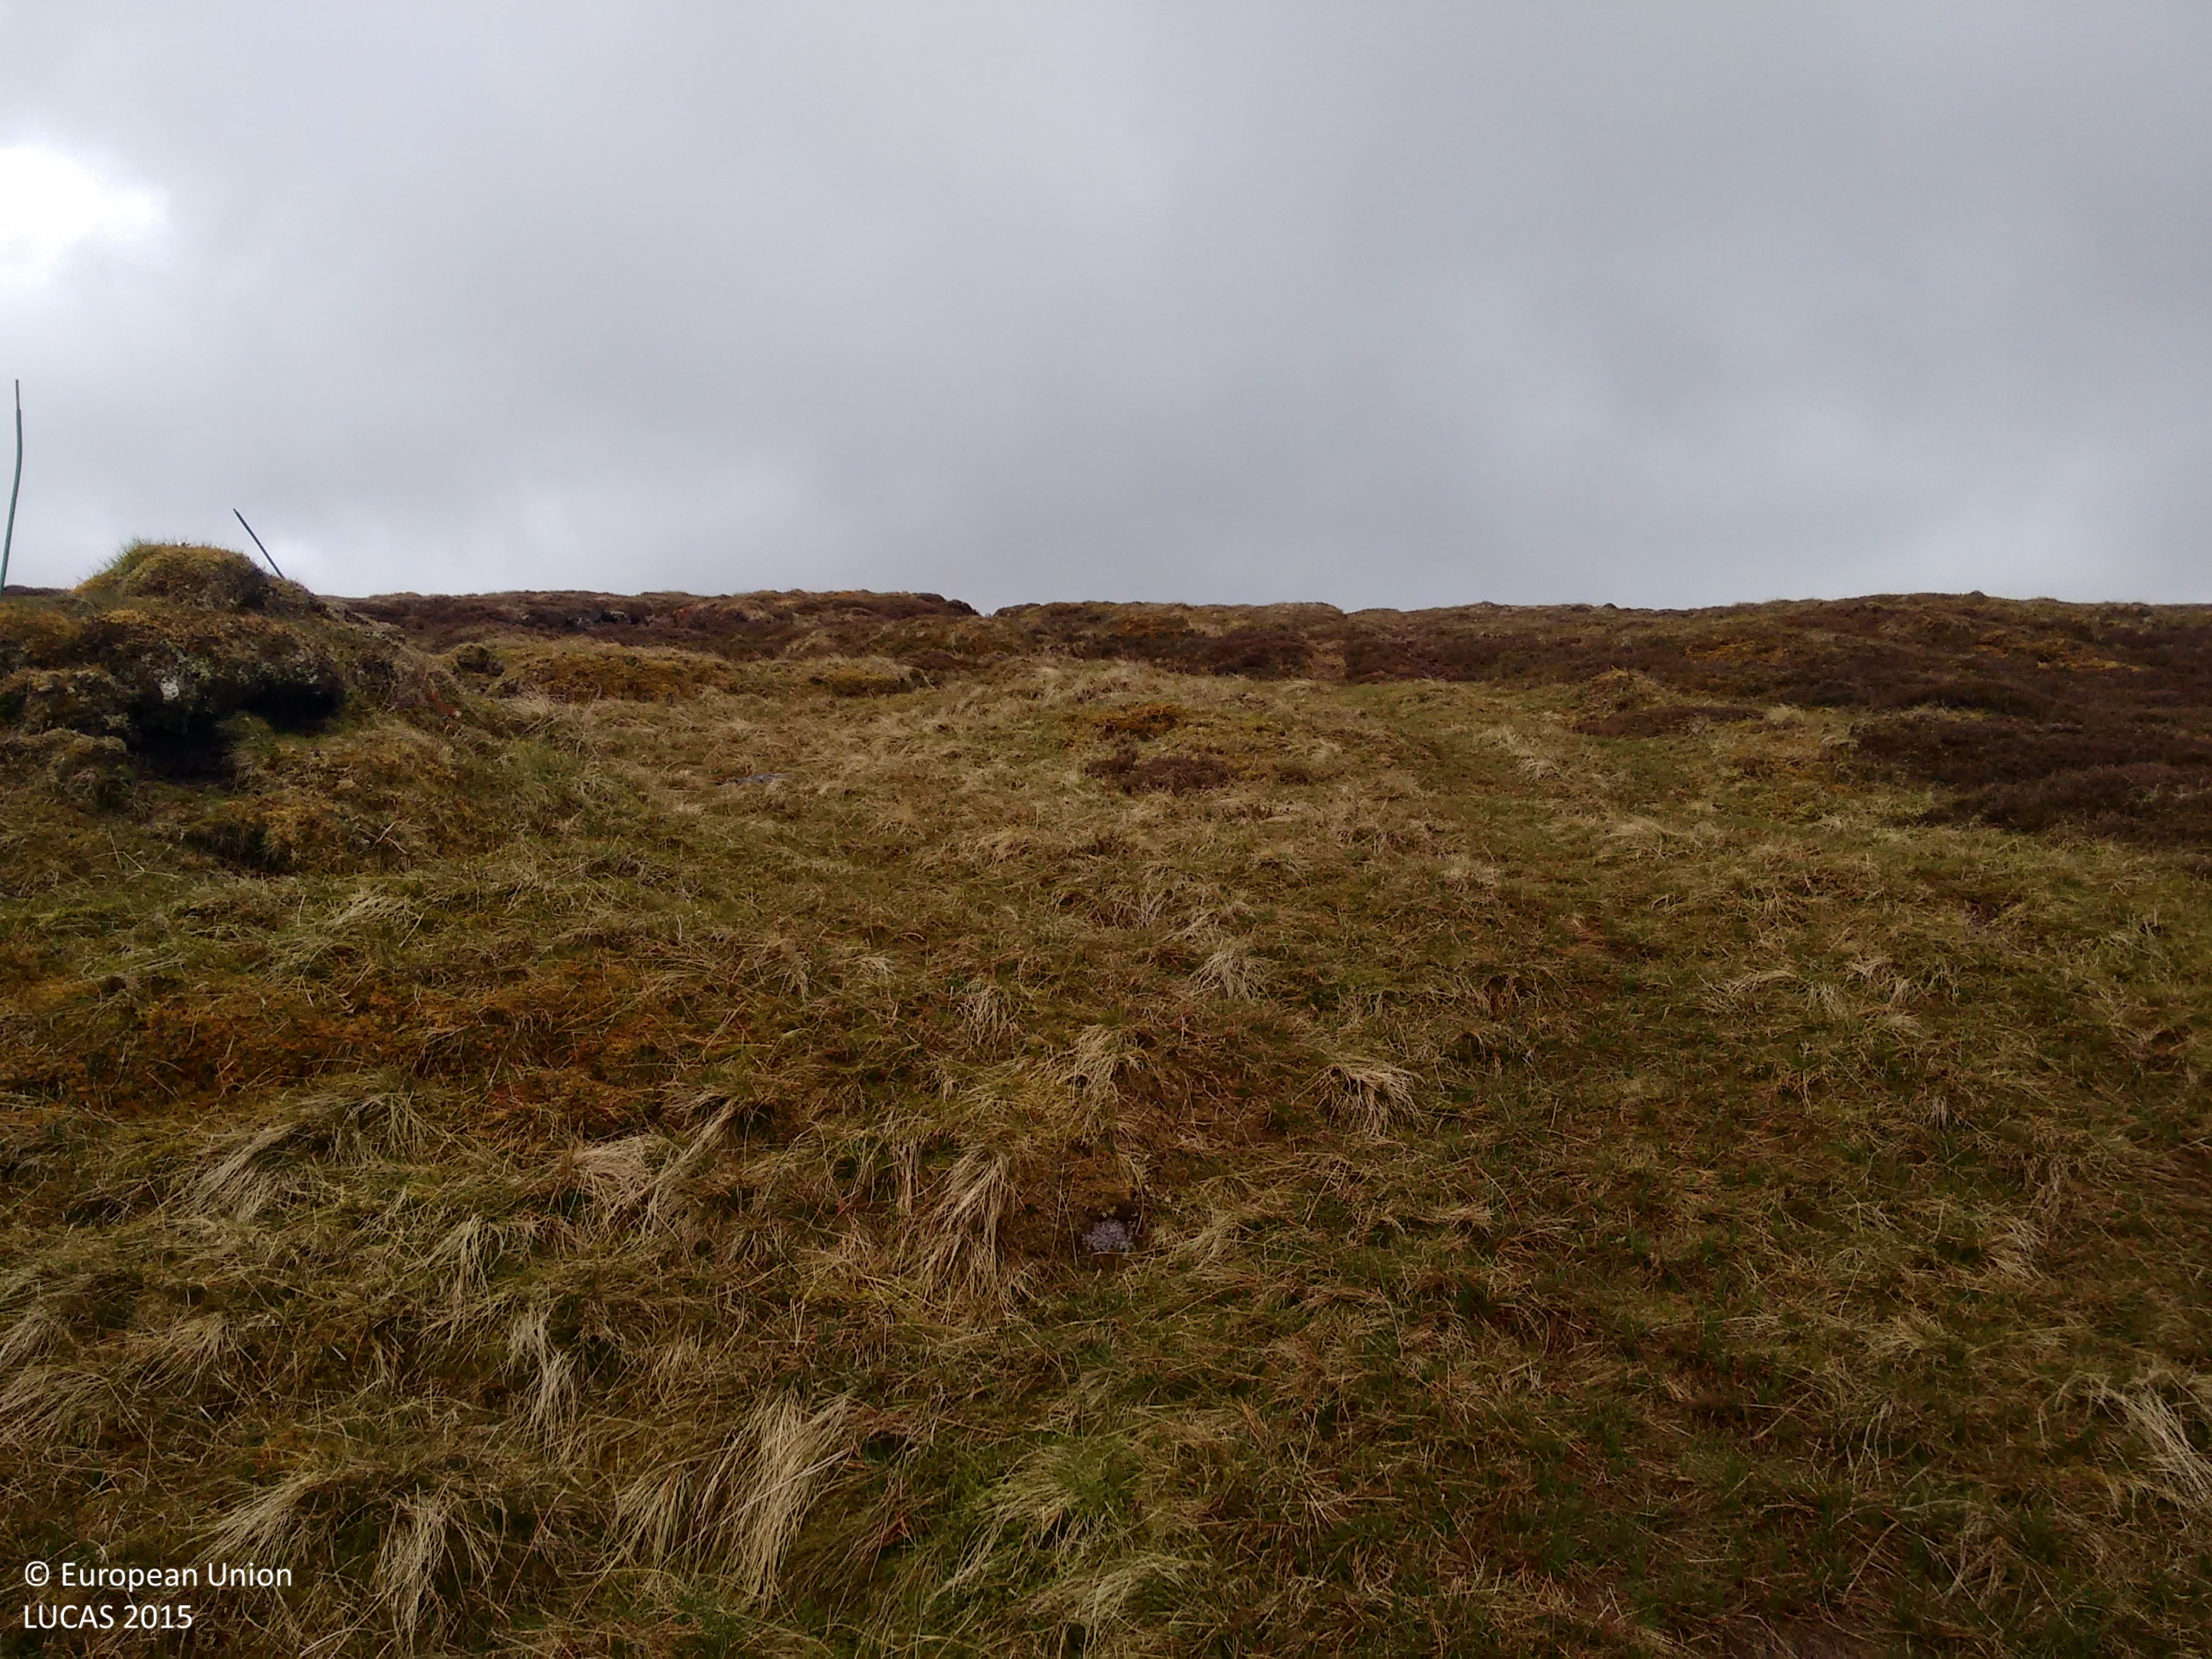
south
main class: Shrubland
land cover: Shrubland without tree cover
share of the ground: > 75 %
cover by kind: herbaceous plants 60 %, shrubs 40 %
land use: Agriculture (excluding fallow land and kitchen gardens)
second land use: Other primary production
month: June
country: GB
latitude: 57.2487
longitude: -4.2912
